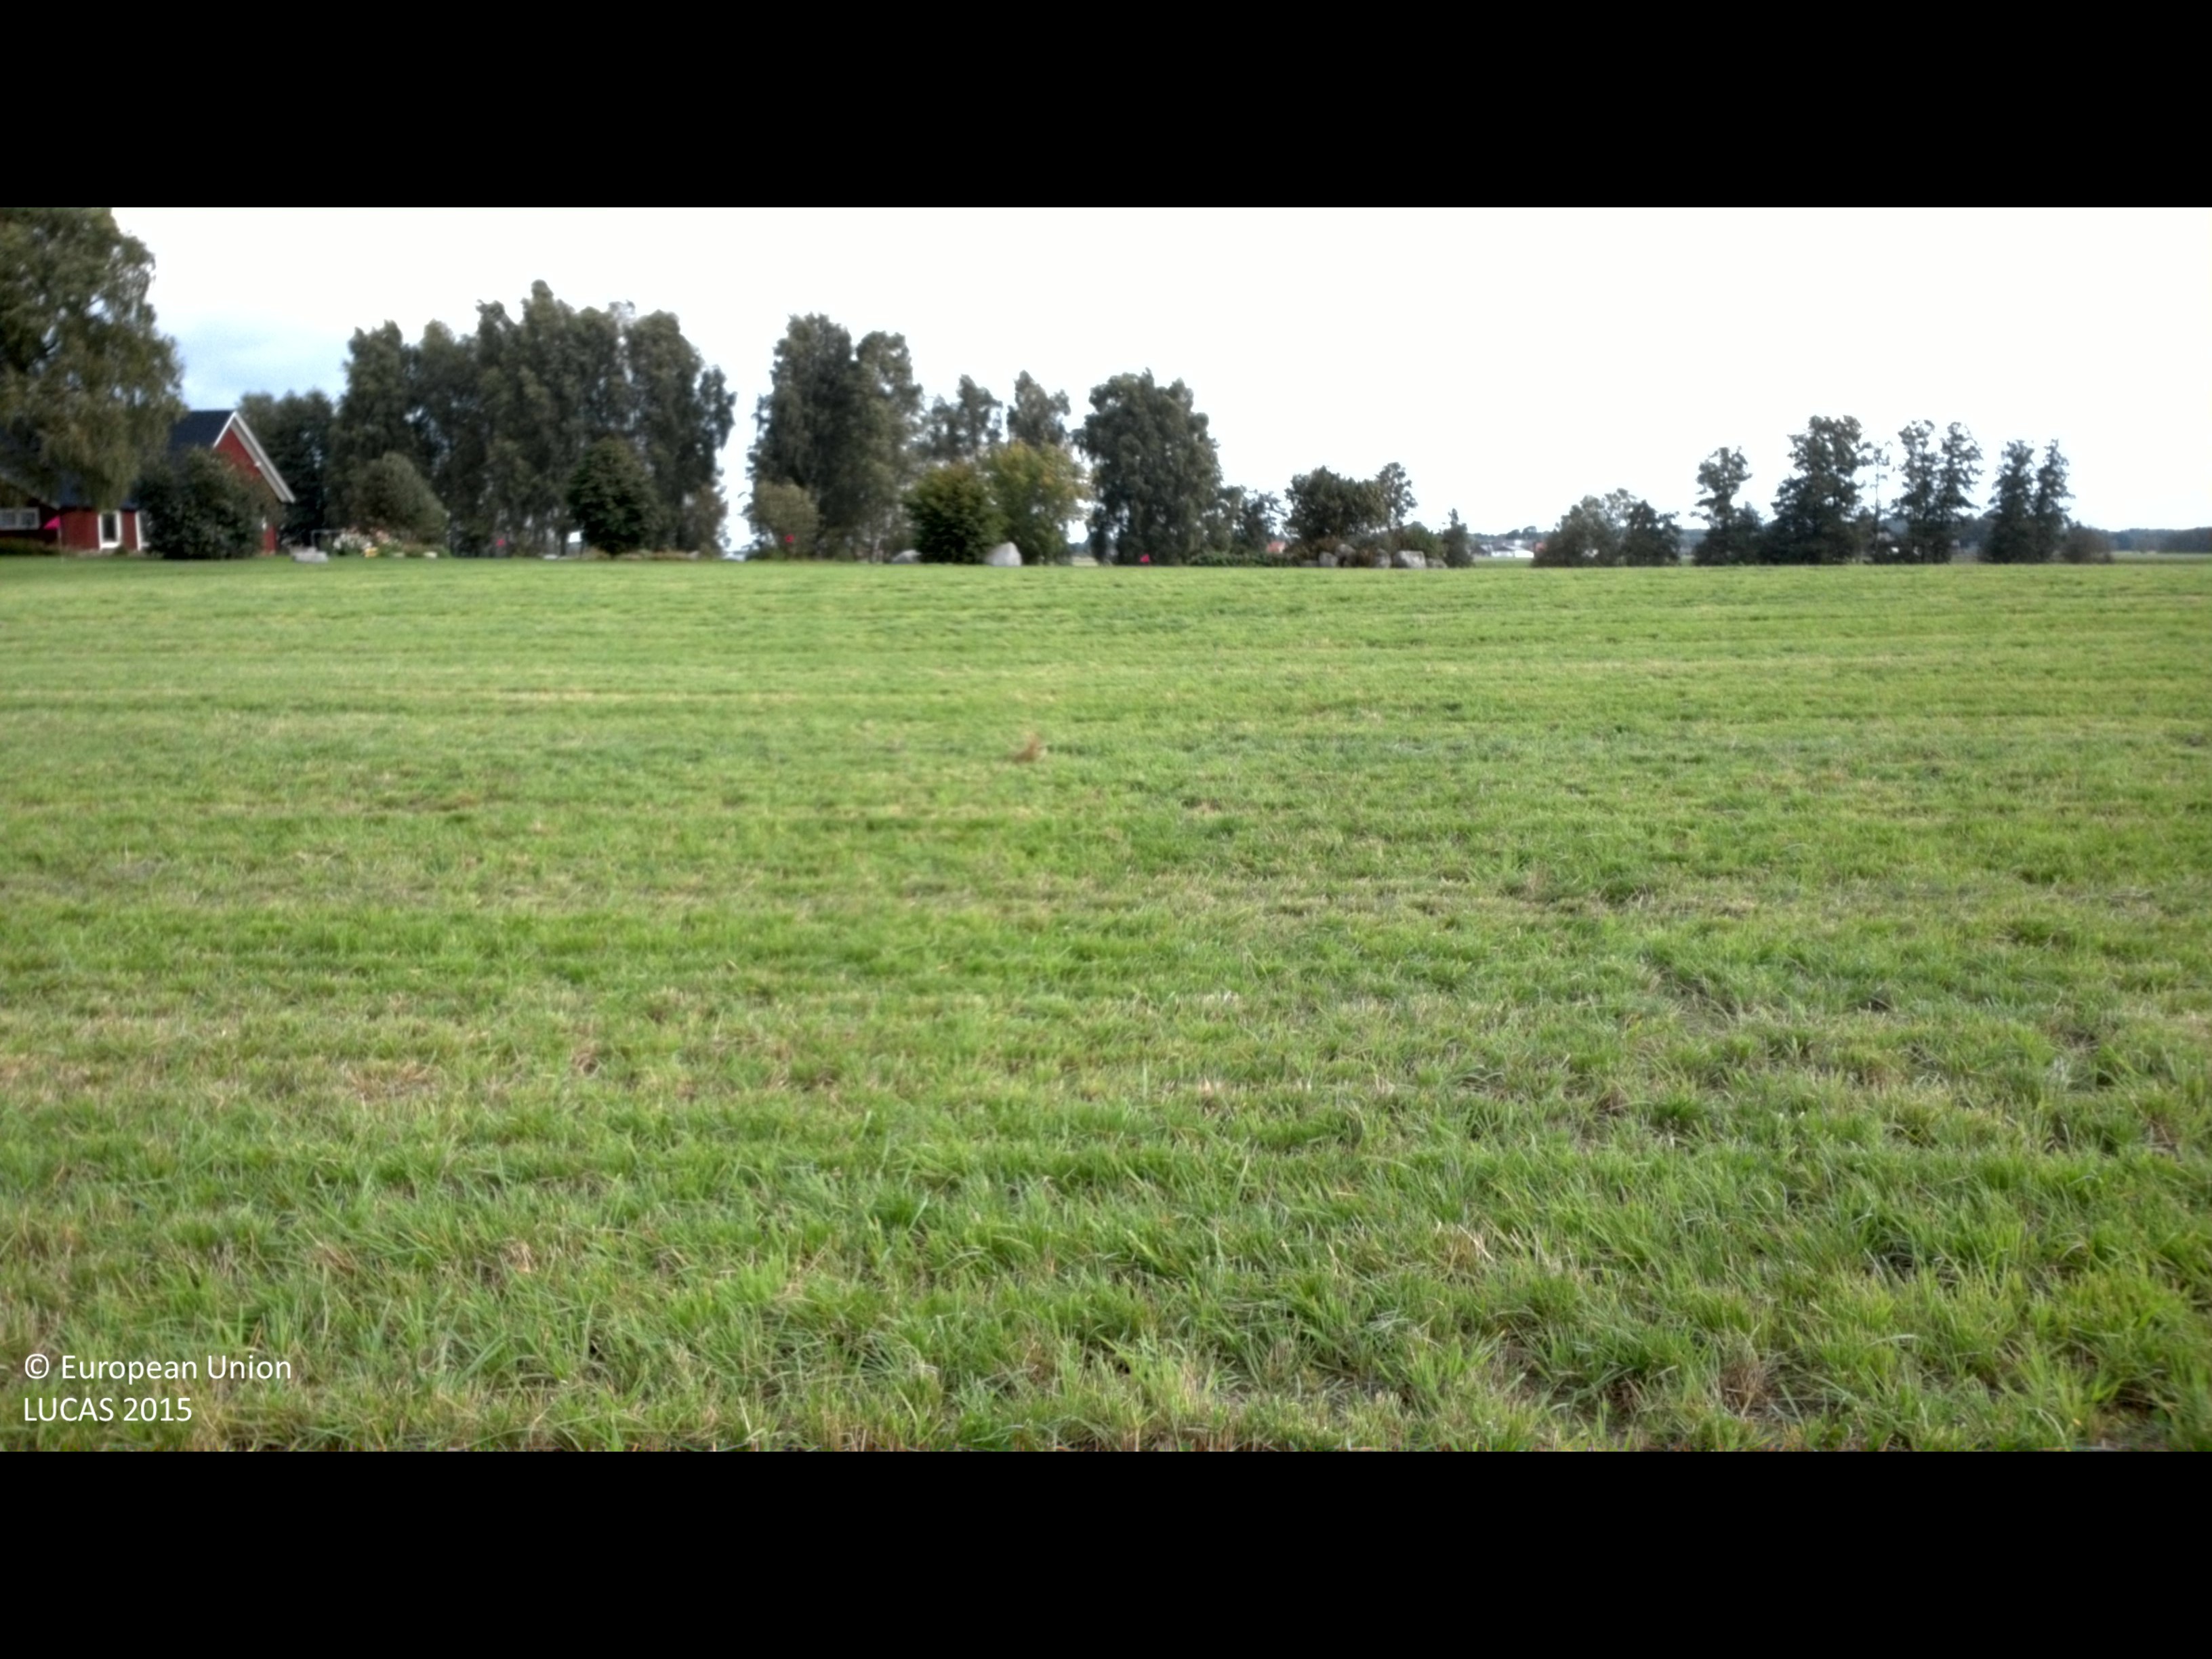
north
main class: Cropland
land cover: Temporary grasslands
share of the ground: > 75 %
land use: Agriculture (excluding fallow land and kitchen gardens)
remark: Harvested field
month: September
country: SE
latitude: 56.2120
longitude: 14.1090
